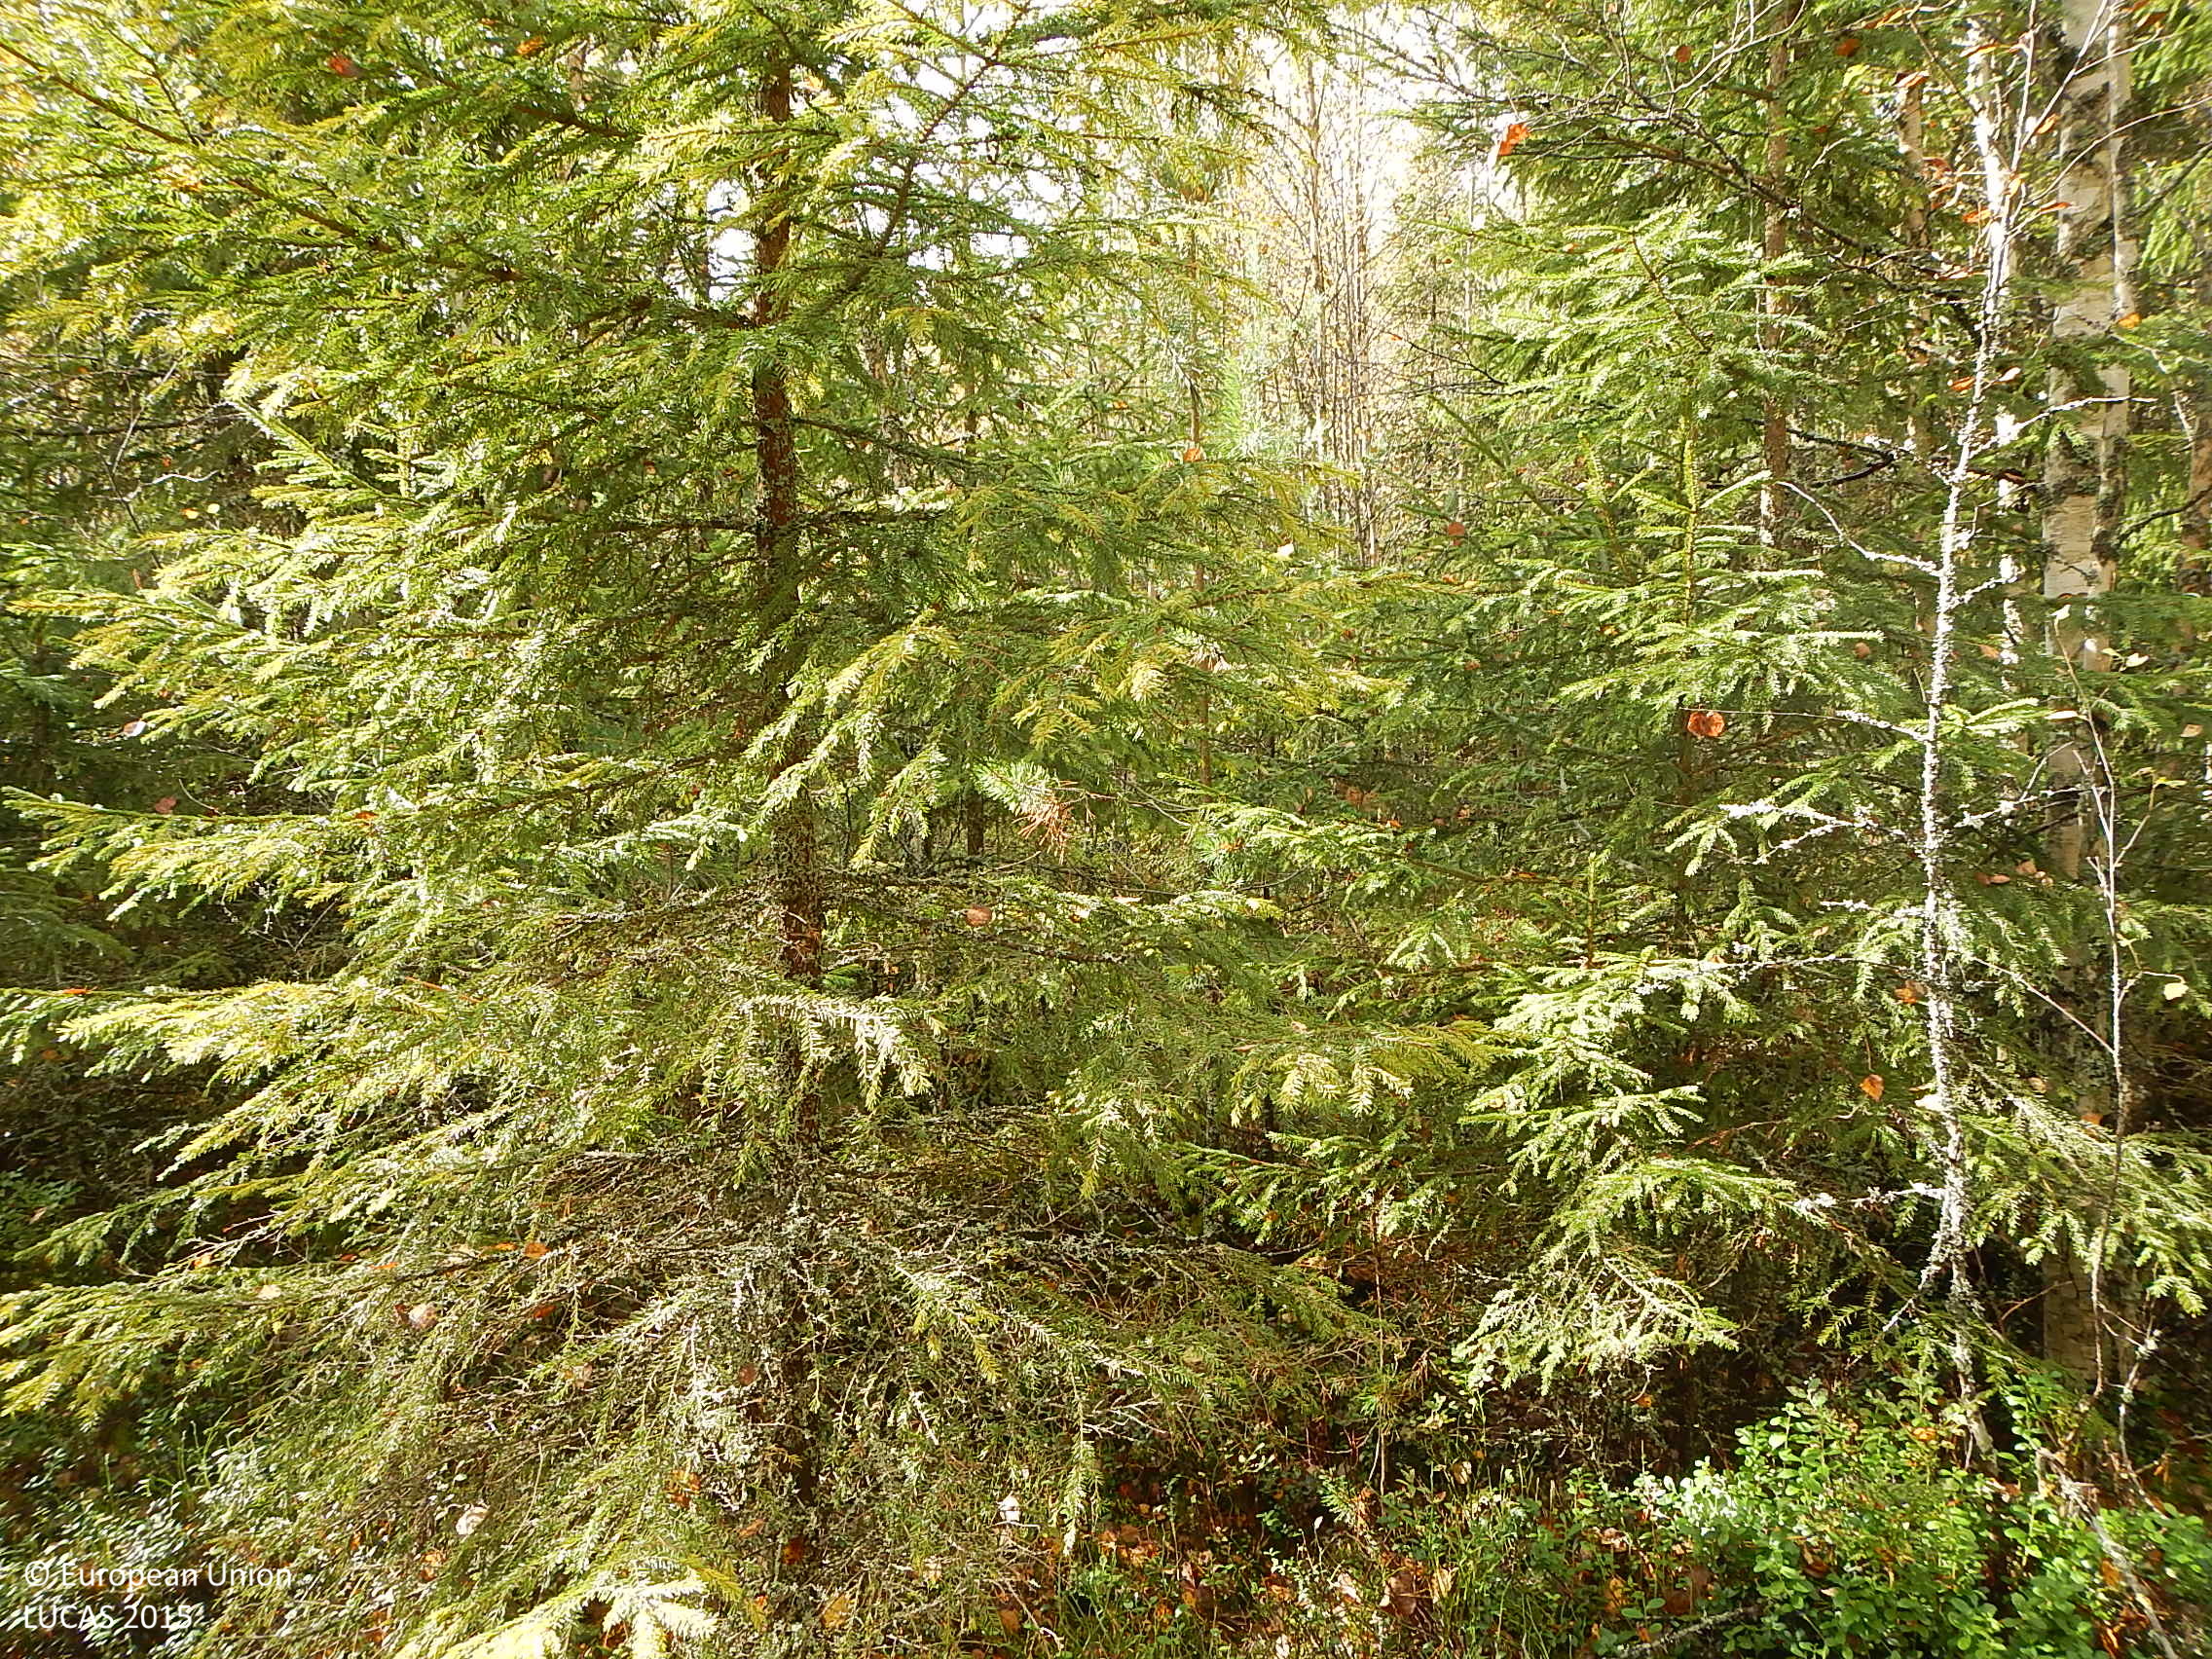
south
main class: Woodland
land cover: Other mixed woodland
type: boreal forest
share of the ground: 50 - 75 %
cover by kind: broadleaved forest trees 40 %, coniferous forest trees 30 %, shrubs 20 %, lichens and mosses 10 %
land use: Forestry
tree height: > 5 m
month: September
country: FI
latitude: 61.8571
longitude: 22.4320
